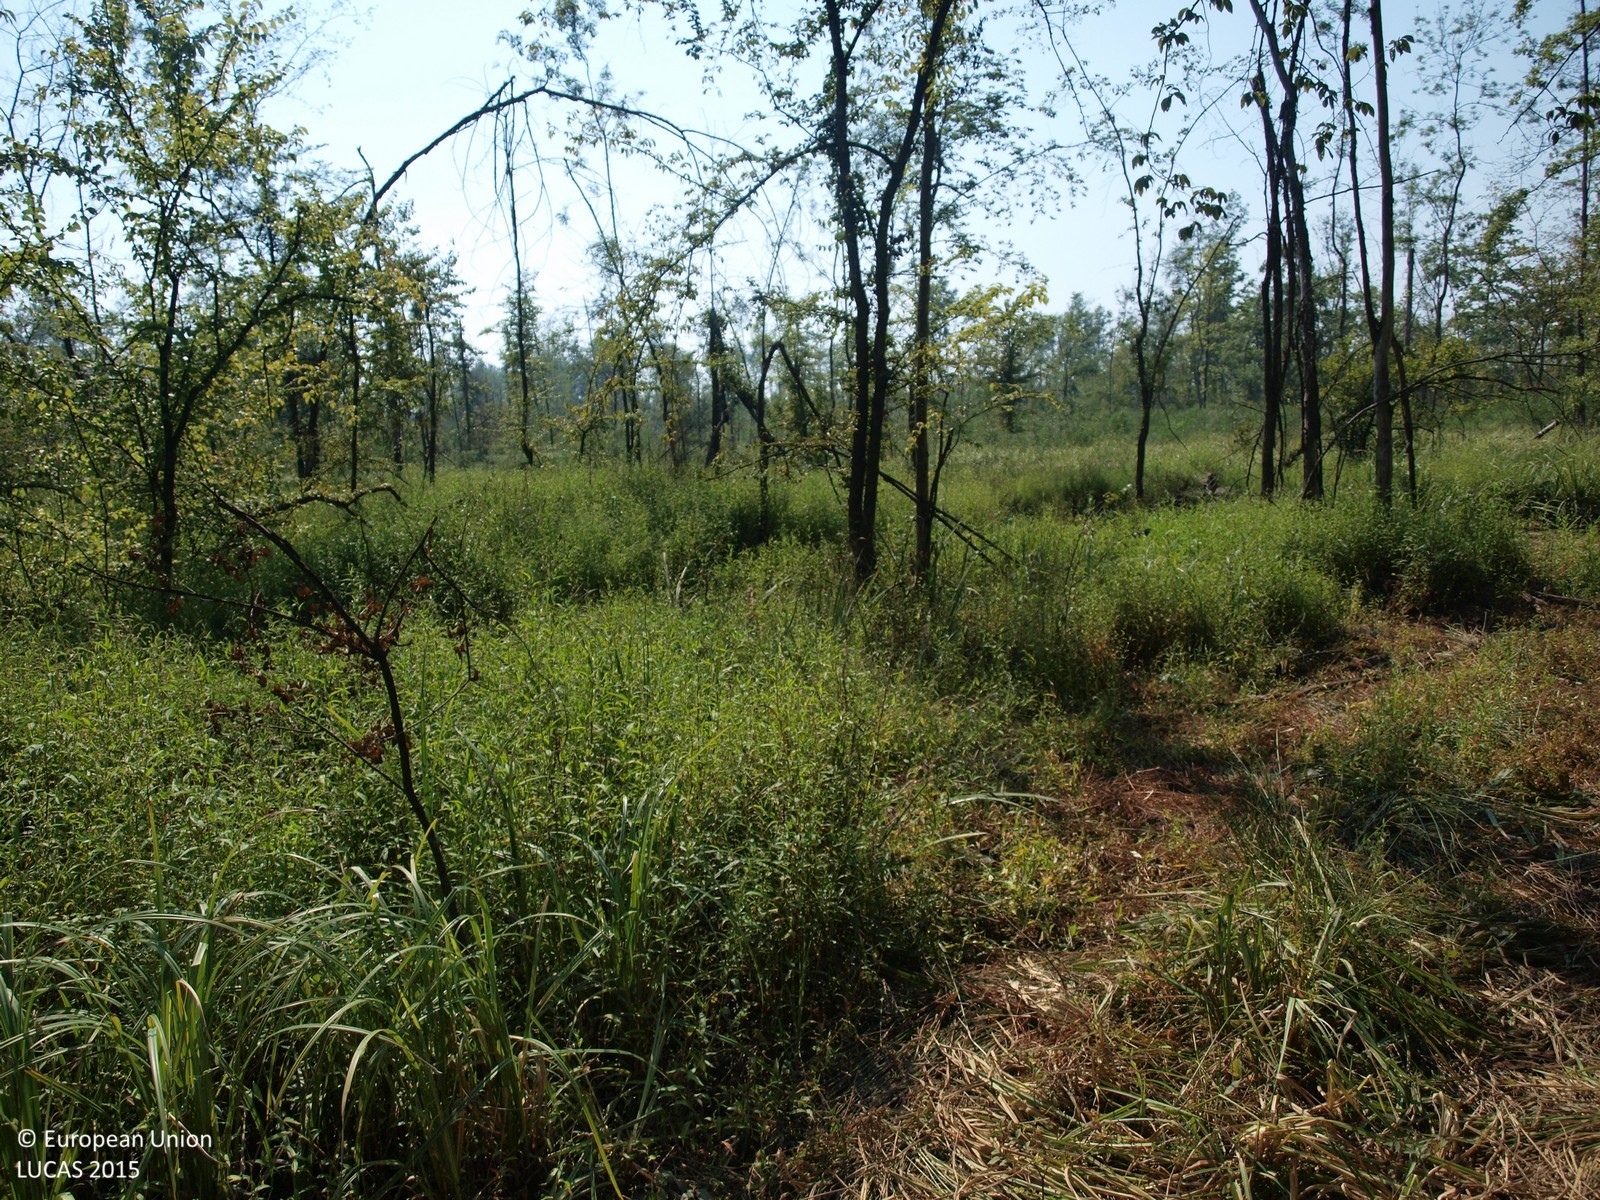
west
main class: Woodland
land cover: Broadleaved woodland
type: floodplain forest
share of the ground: > 75 %
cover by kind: broadleaved forest trees 100 %
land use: Forestry
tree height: > 5 m
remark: Clear cut
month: August
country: HR
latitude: 45.5950
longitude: 16.4721
